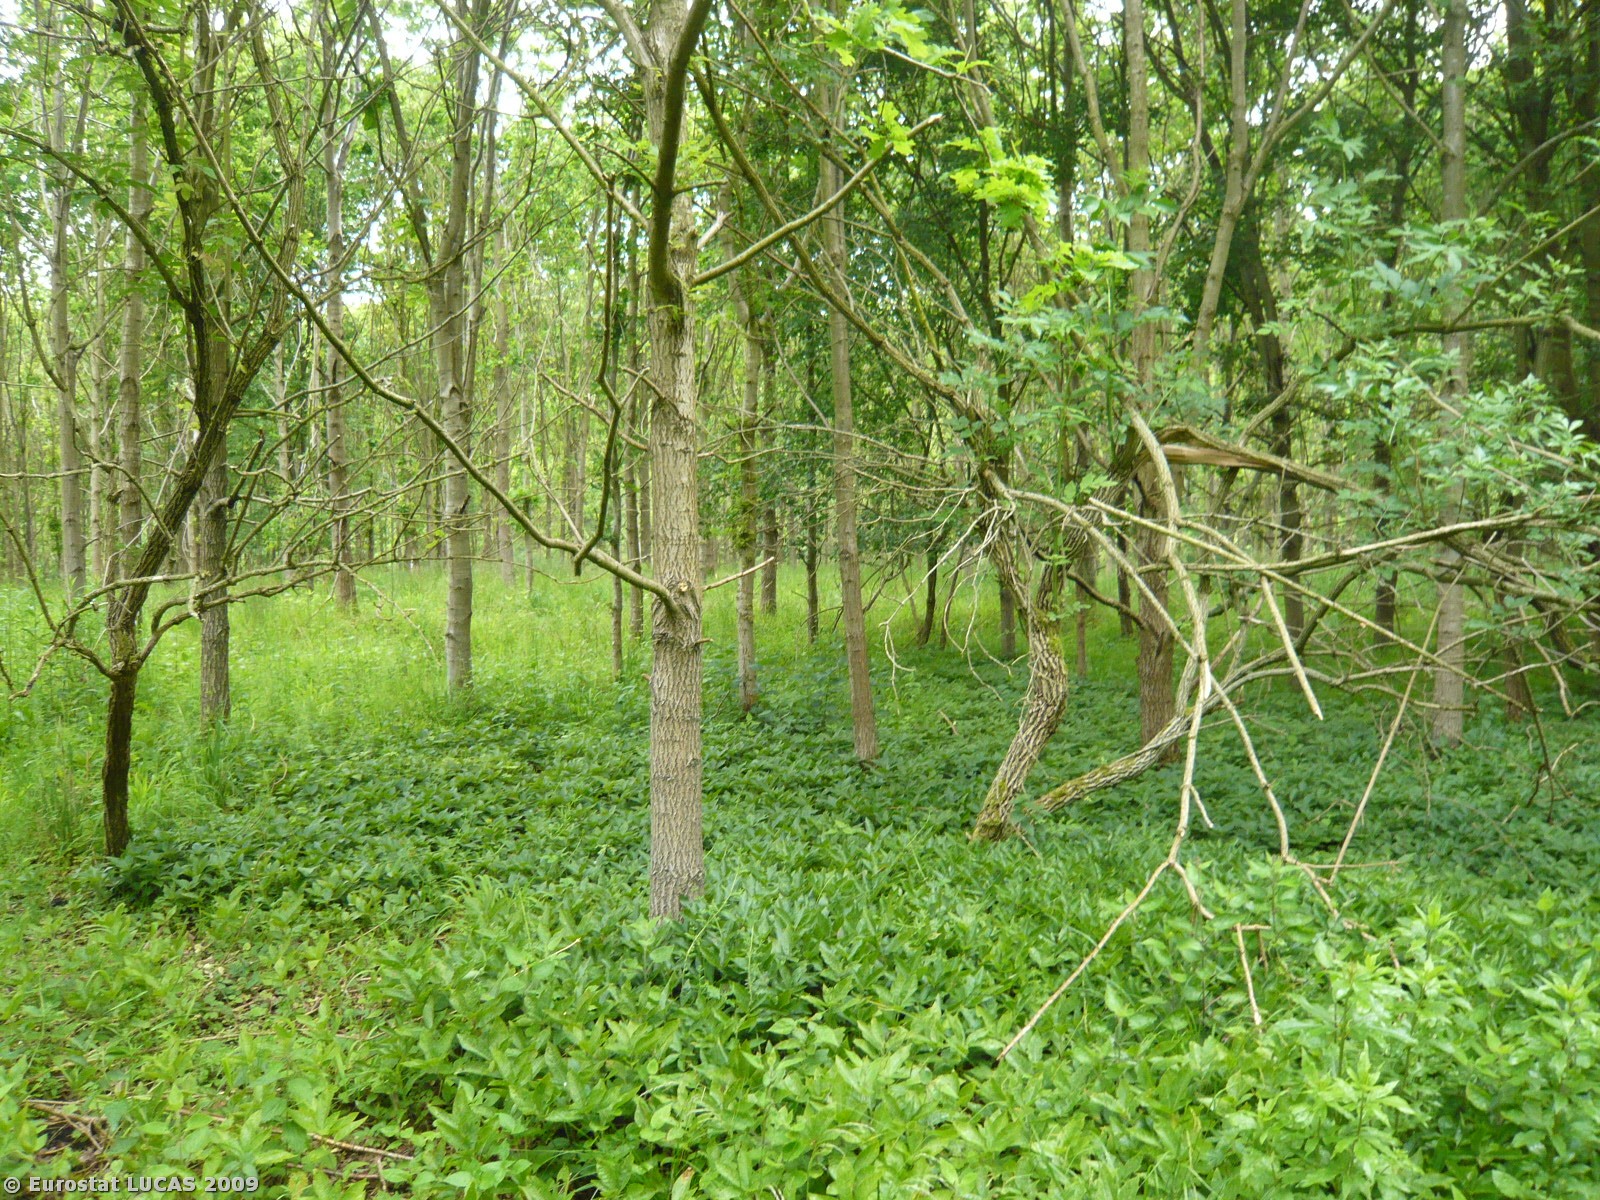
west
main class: Woodland
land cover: Broadleaved woodland
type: plantations and self-sown exotic forest
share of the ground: > 75 %
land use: Forestry
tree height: > 5 m
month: June
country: DK
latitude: 54.7532
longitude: 11.9100
